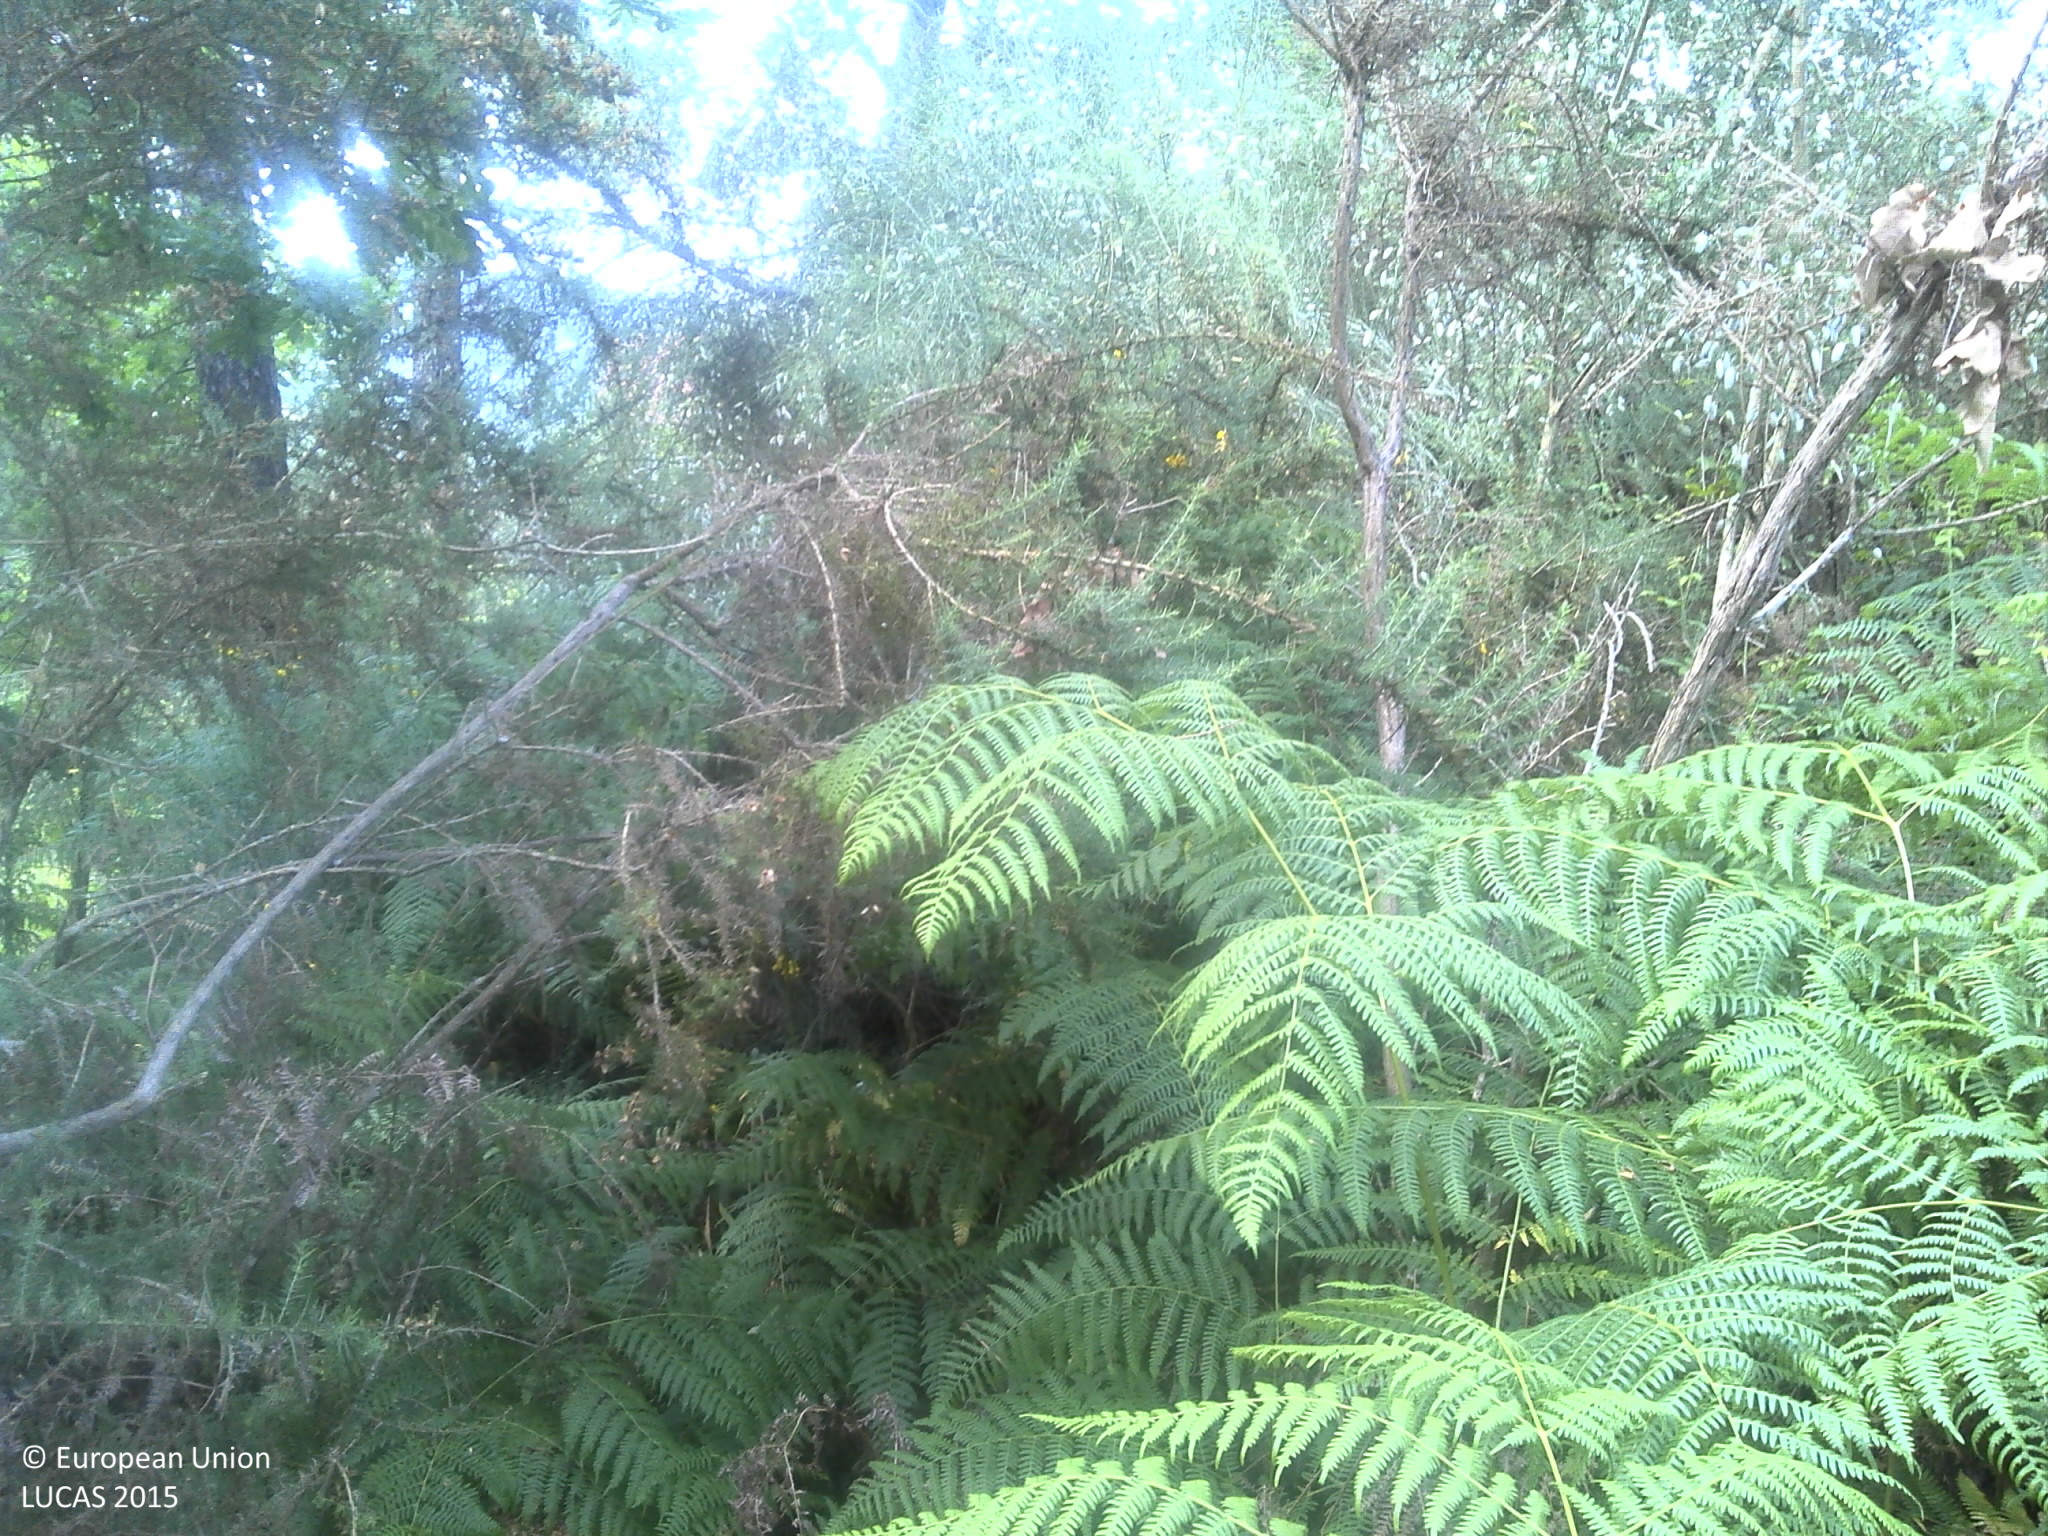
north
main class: Shrubland
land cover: Shrubland with sparse tree cover
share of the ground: > 75 %
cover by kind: shrubs 80 %, herbaceous plants 10 %, broadleaved forest trees 5 %, unconsolidated bare surface 5 %
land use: Abandoned areas
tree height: < 5 m
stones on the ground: < 10 %
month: June
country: PT
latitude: 41.6760
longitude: -8.3767
